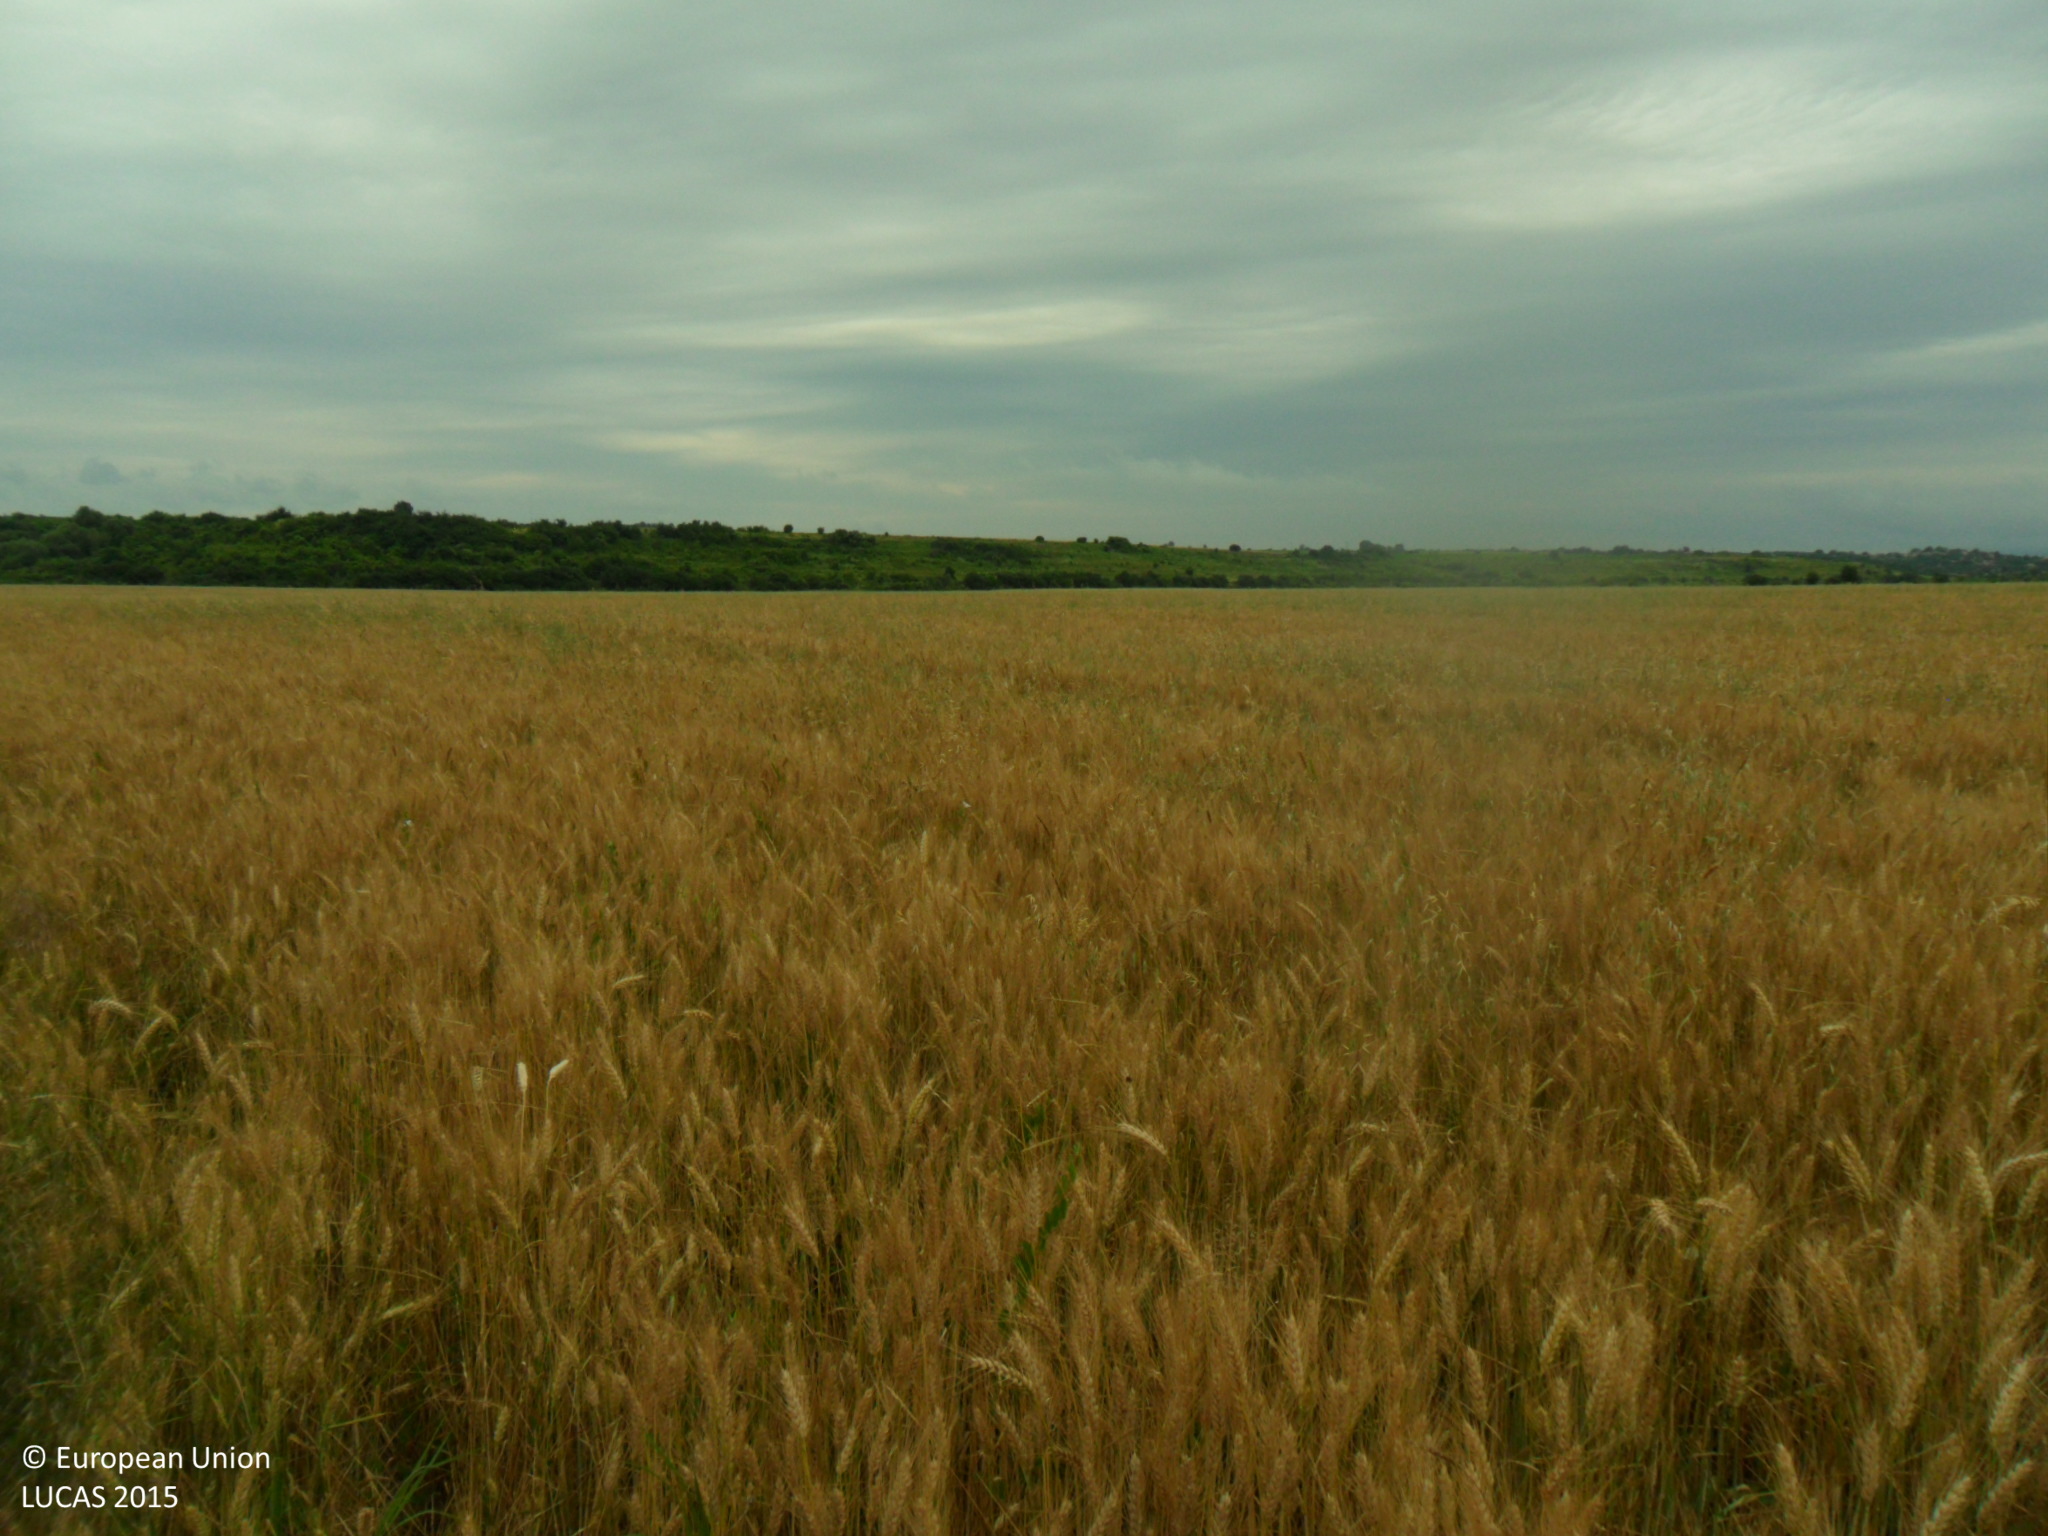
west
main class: Cropland
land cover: Common wheat
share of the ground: > 75 %
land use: Agriculture (excluding fallow land and kitchen gardens)
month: June
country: BG
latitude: 43.1564
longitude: 26.9982
